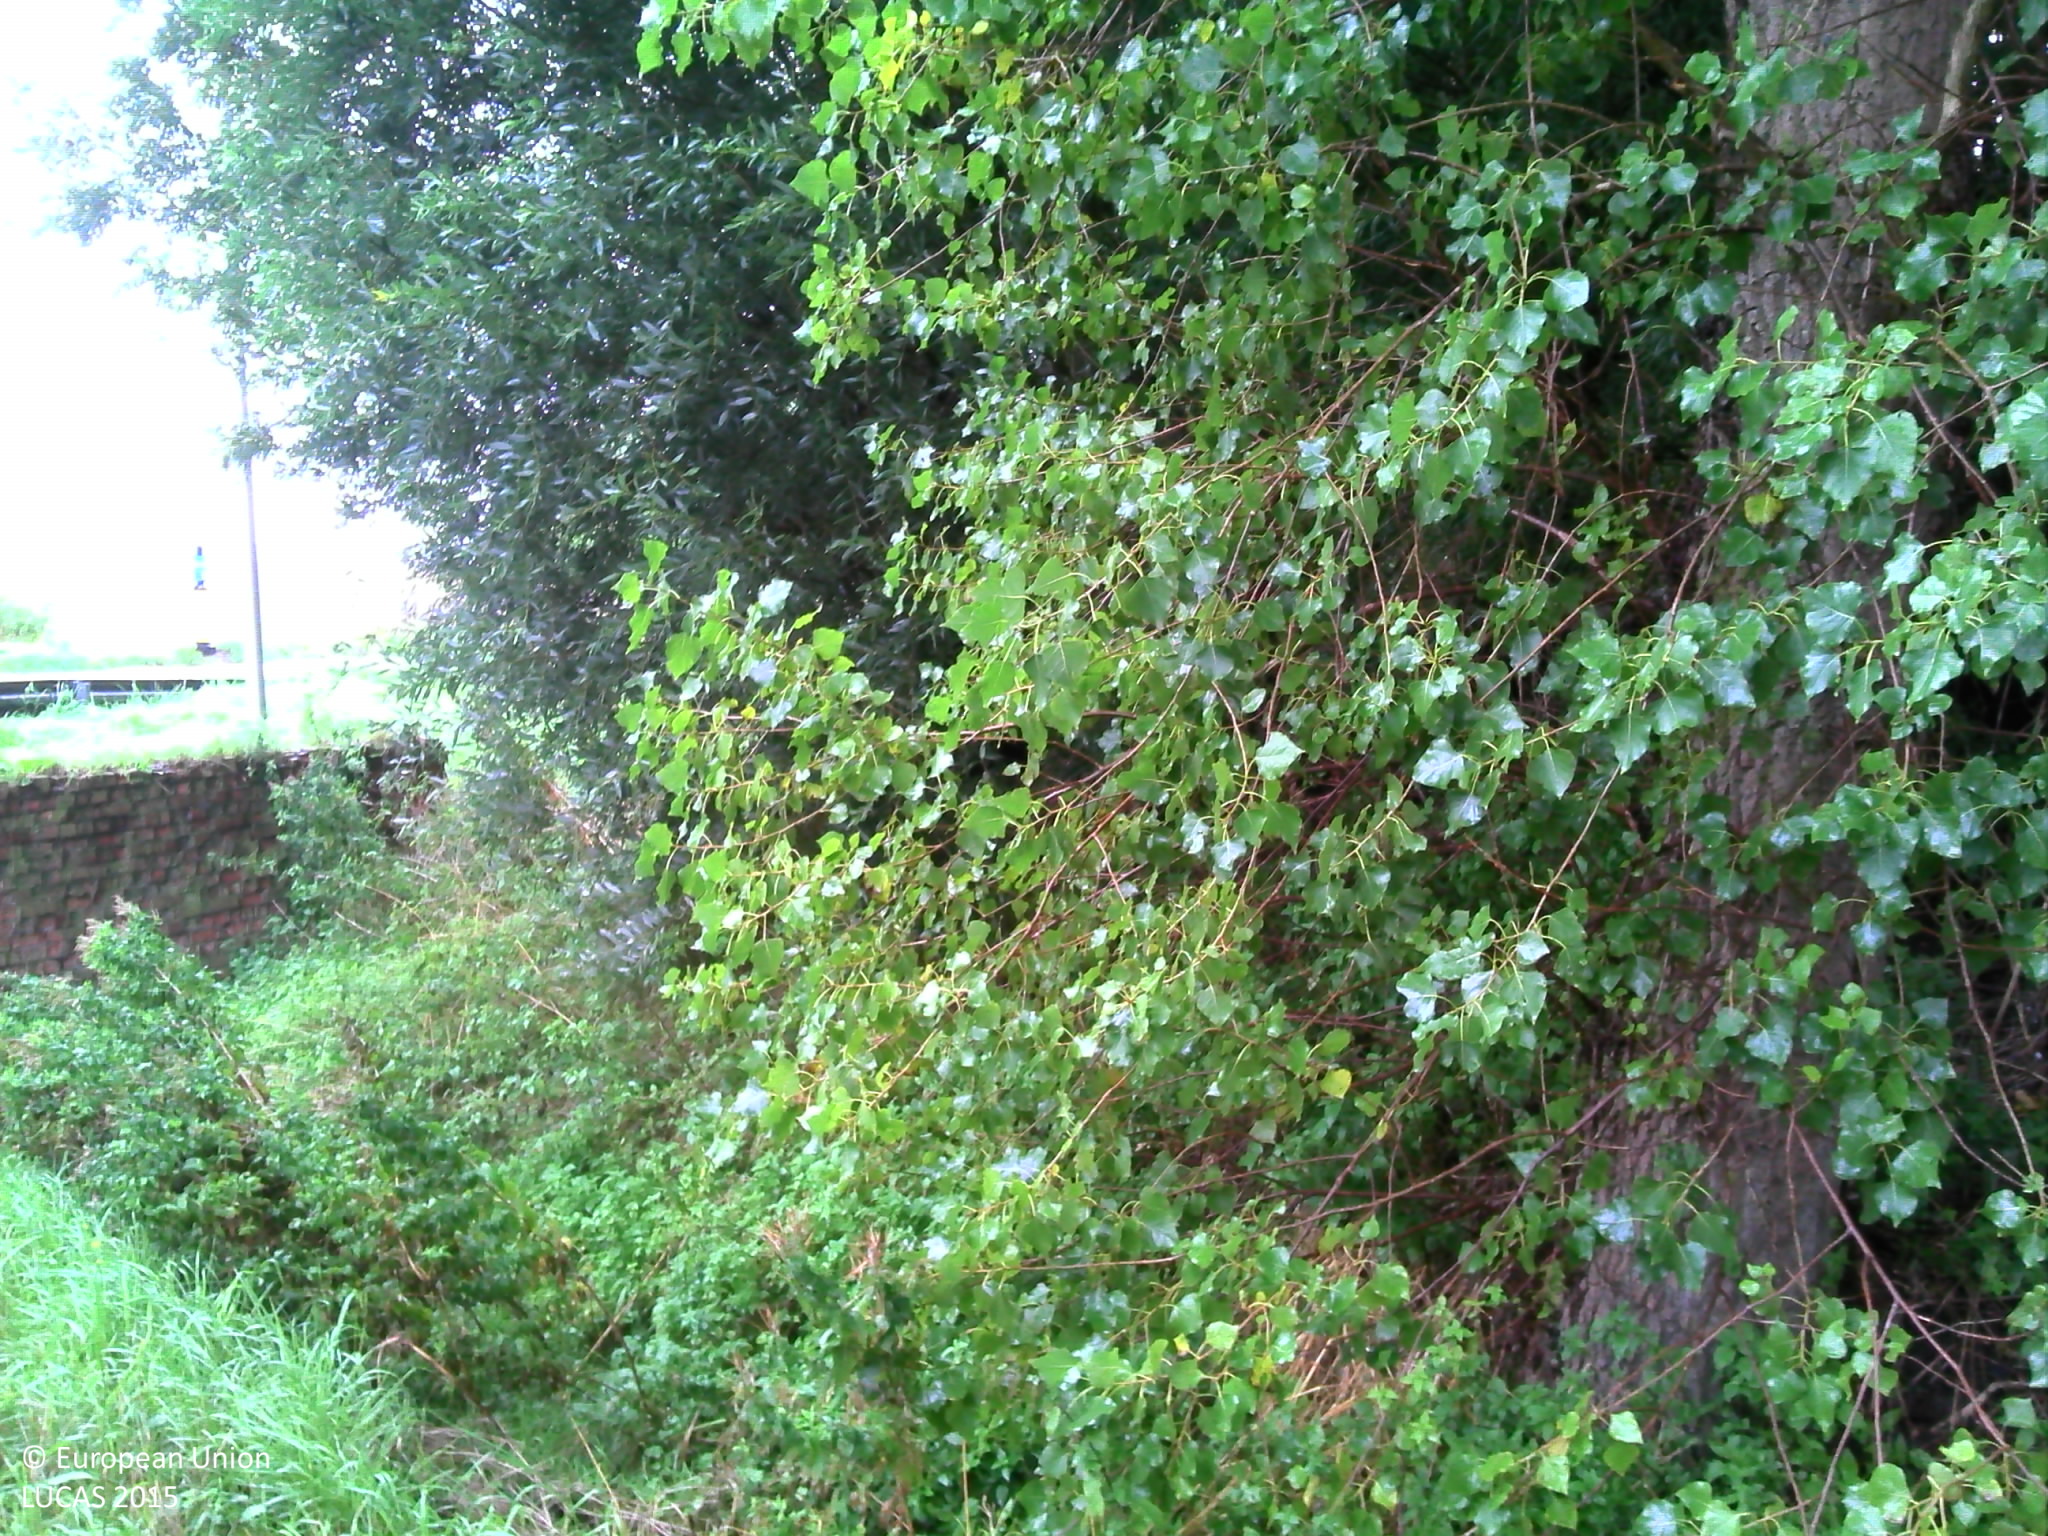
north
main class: Woodland
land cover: Broadleaved woodland
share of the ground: > 75 %
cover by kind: broadleaved forest trees 90 %, herbaceous plants 10 %
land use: Road transport
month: September
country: BE
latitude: 51.2189
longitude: 3.0750
